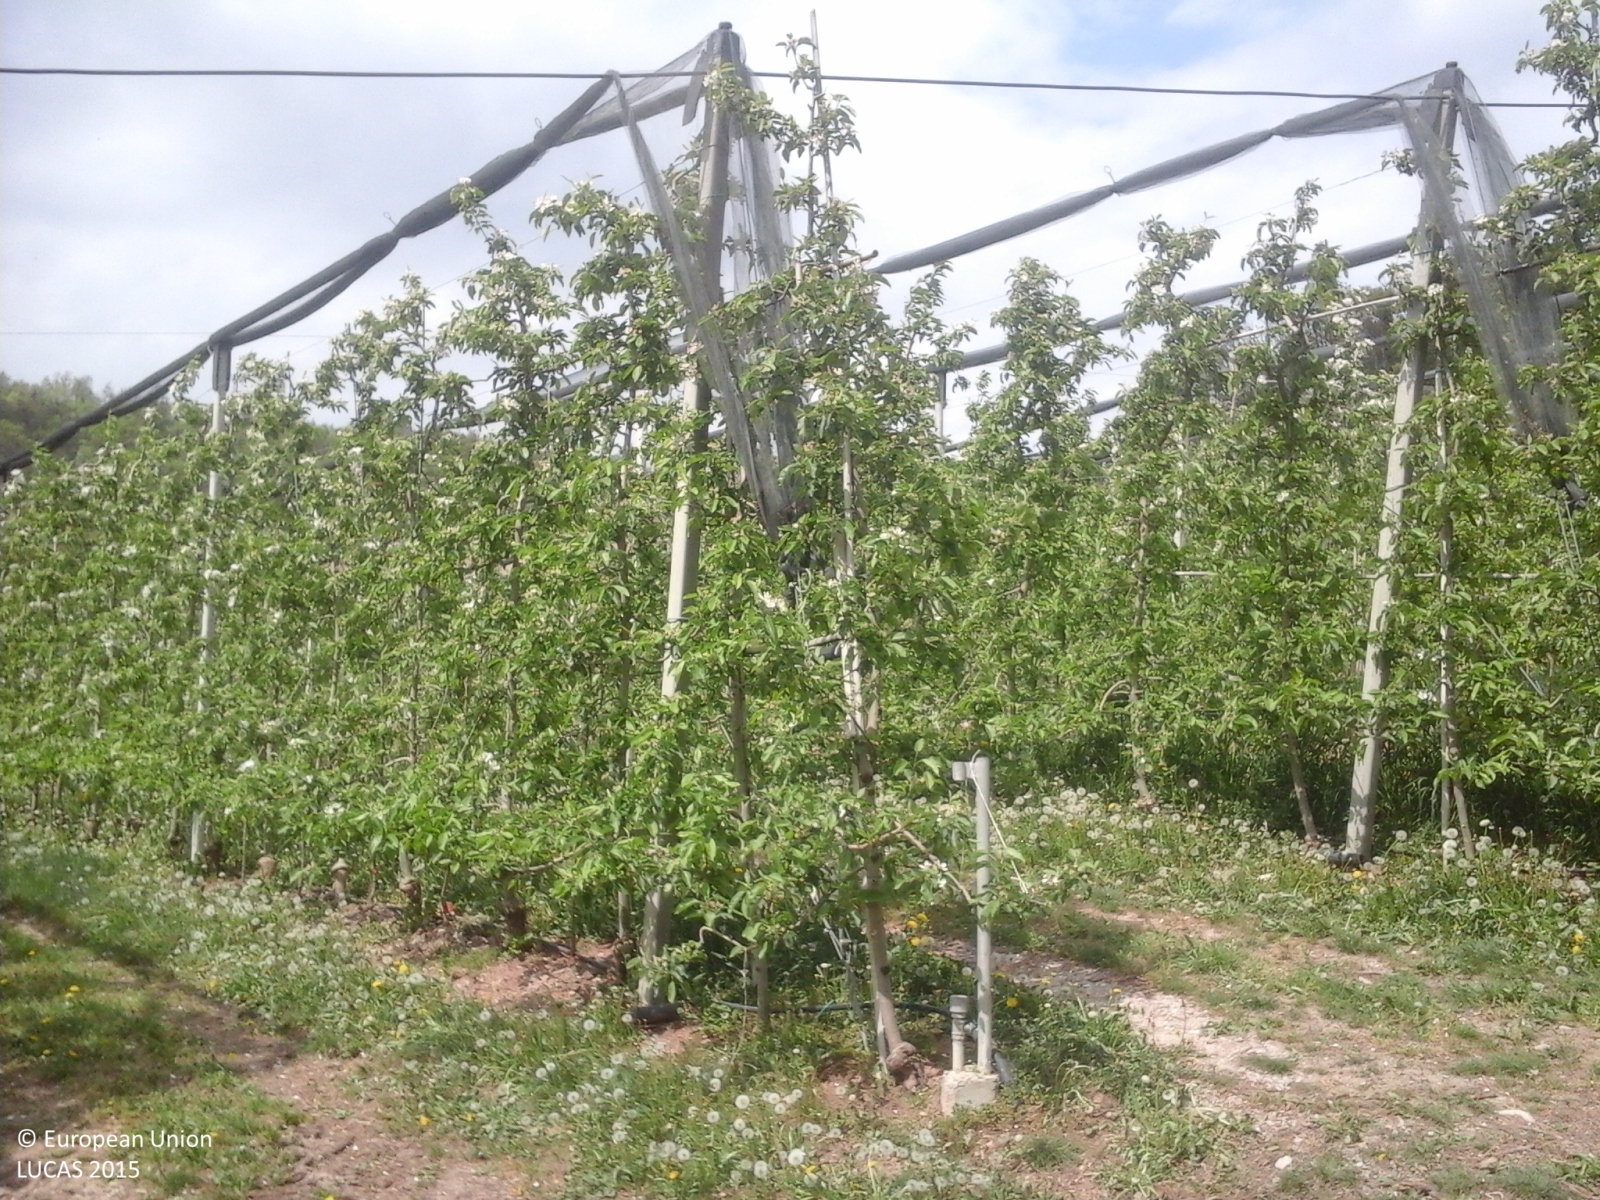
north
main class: Woodland
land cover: Broadleaved woodland
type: thermophilous deciduous forest
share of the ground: > 75 %
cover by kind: broadleaved forest trees 100 %
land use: Forestry
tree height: > 5 m
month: April
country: IT
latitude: 46.2915
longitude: 11.1019
